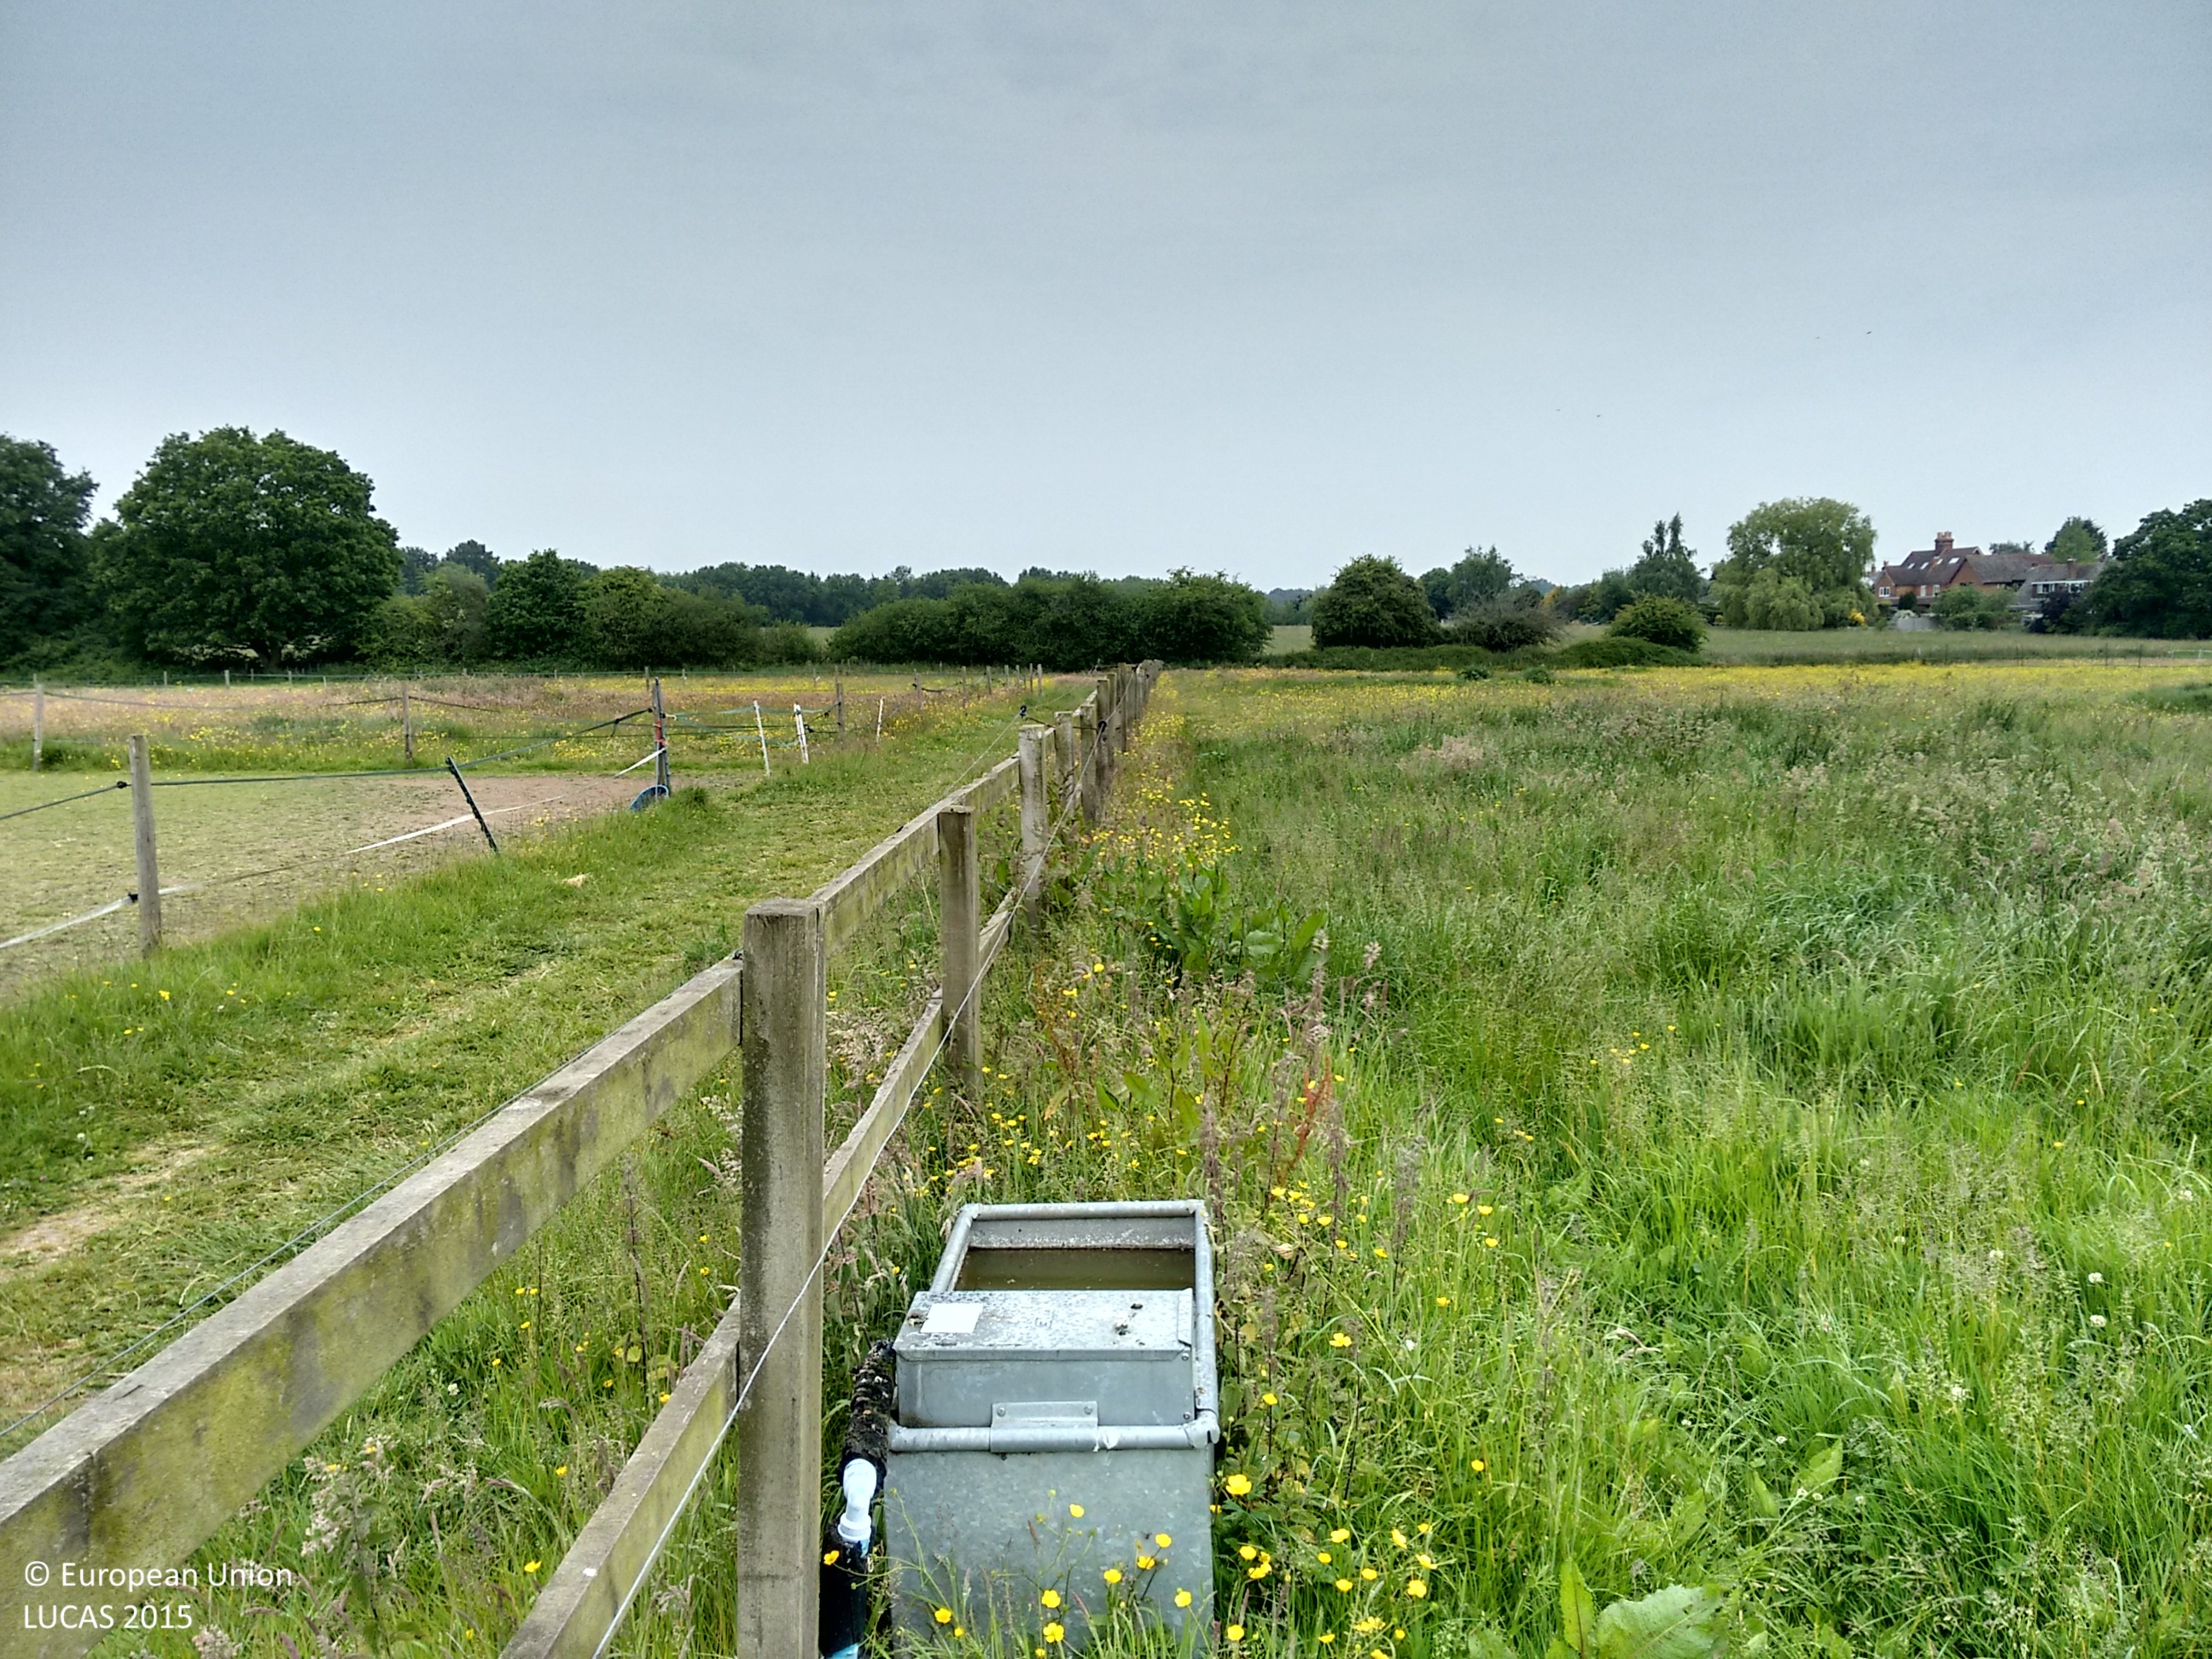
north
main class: Grassland
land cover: Grassland without tree/shrub cover
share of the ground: > 75 %
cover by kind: herbaceous plants 100 %
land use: Agriculture (excluding fallow land and kitchen gardens)
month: June
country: GB
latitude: 51.4136
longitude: -1.1610
